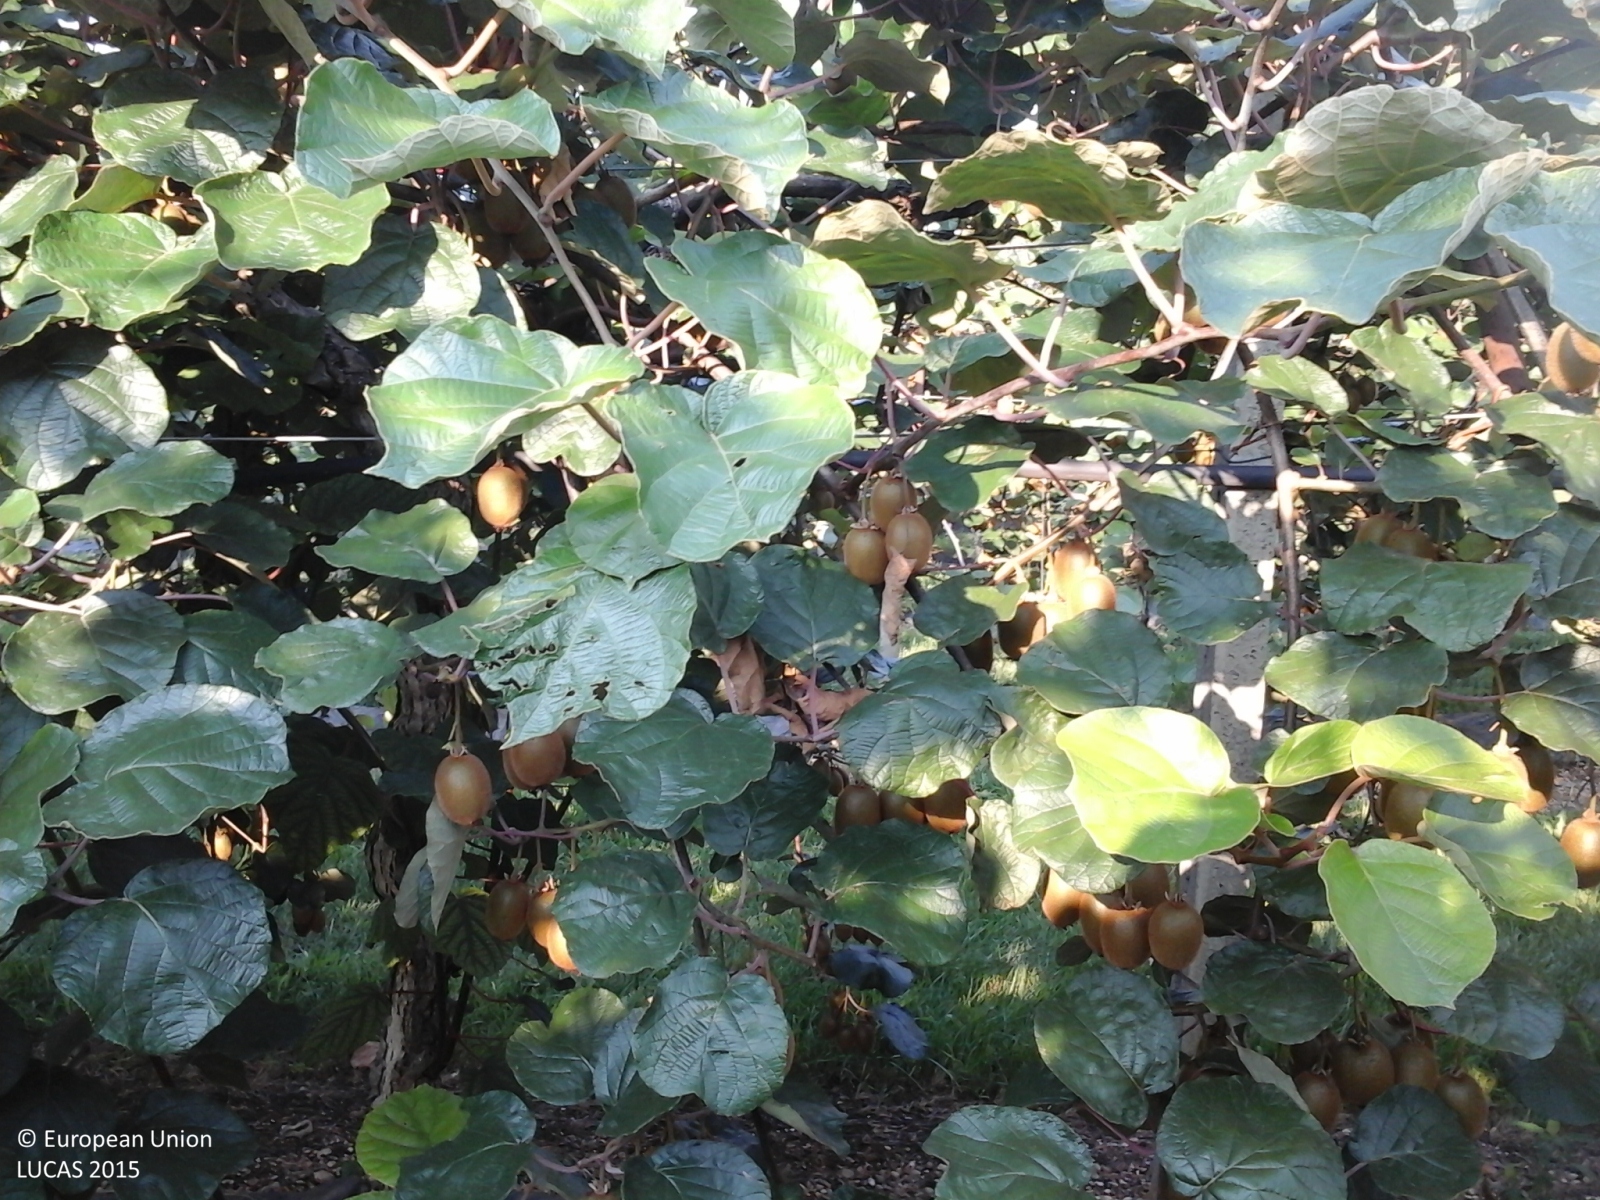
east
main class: Cropland
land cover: Other fruit trees and berries
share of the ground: > 75 %
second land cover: Grassland without tree/shrub cover
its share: > 75 %
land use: Agriculture (excluding fallow land and kitchen gardens)
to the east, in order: Other fruit trees and berries; Grassland without tree/shrub cover; Lucerne; Vineyards; Artificial constructions in urban areas; Ditches and canals; Maize; Ditches and canals
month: July
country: IT
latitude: 45.3741
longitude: 10.9305
